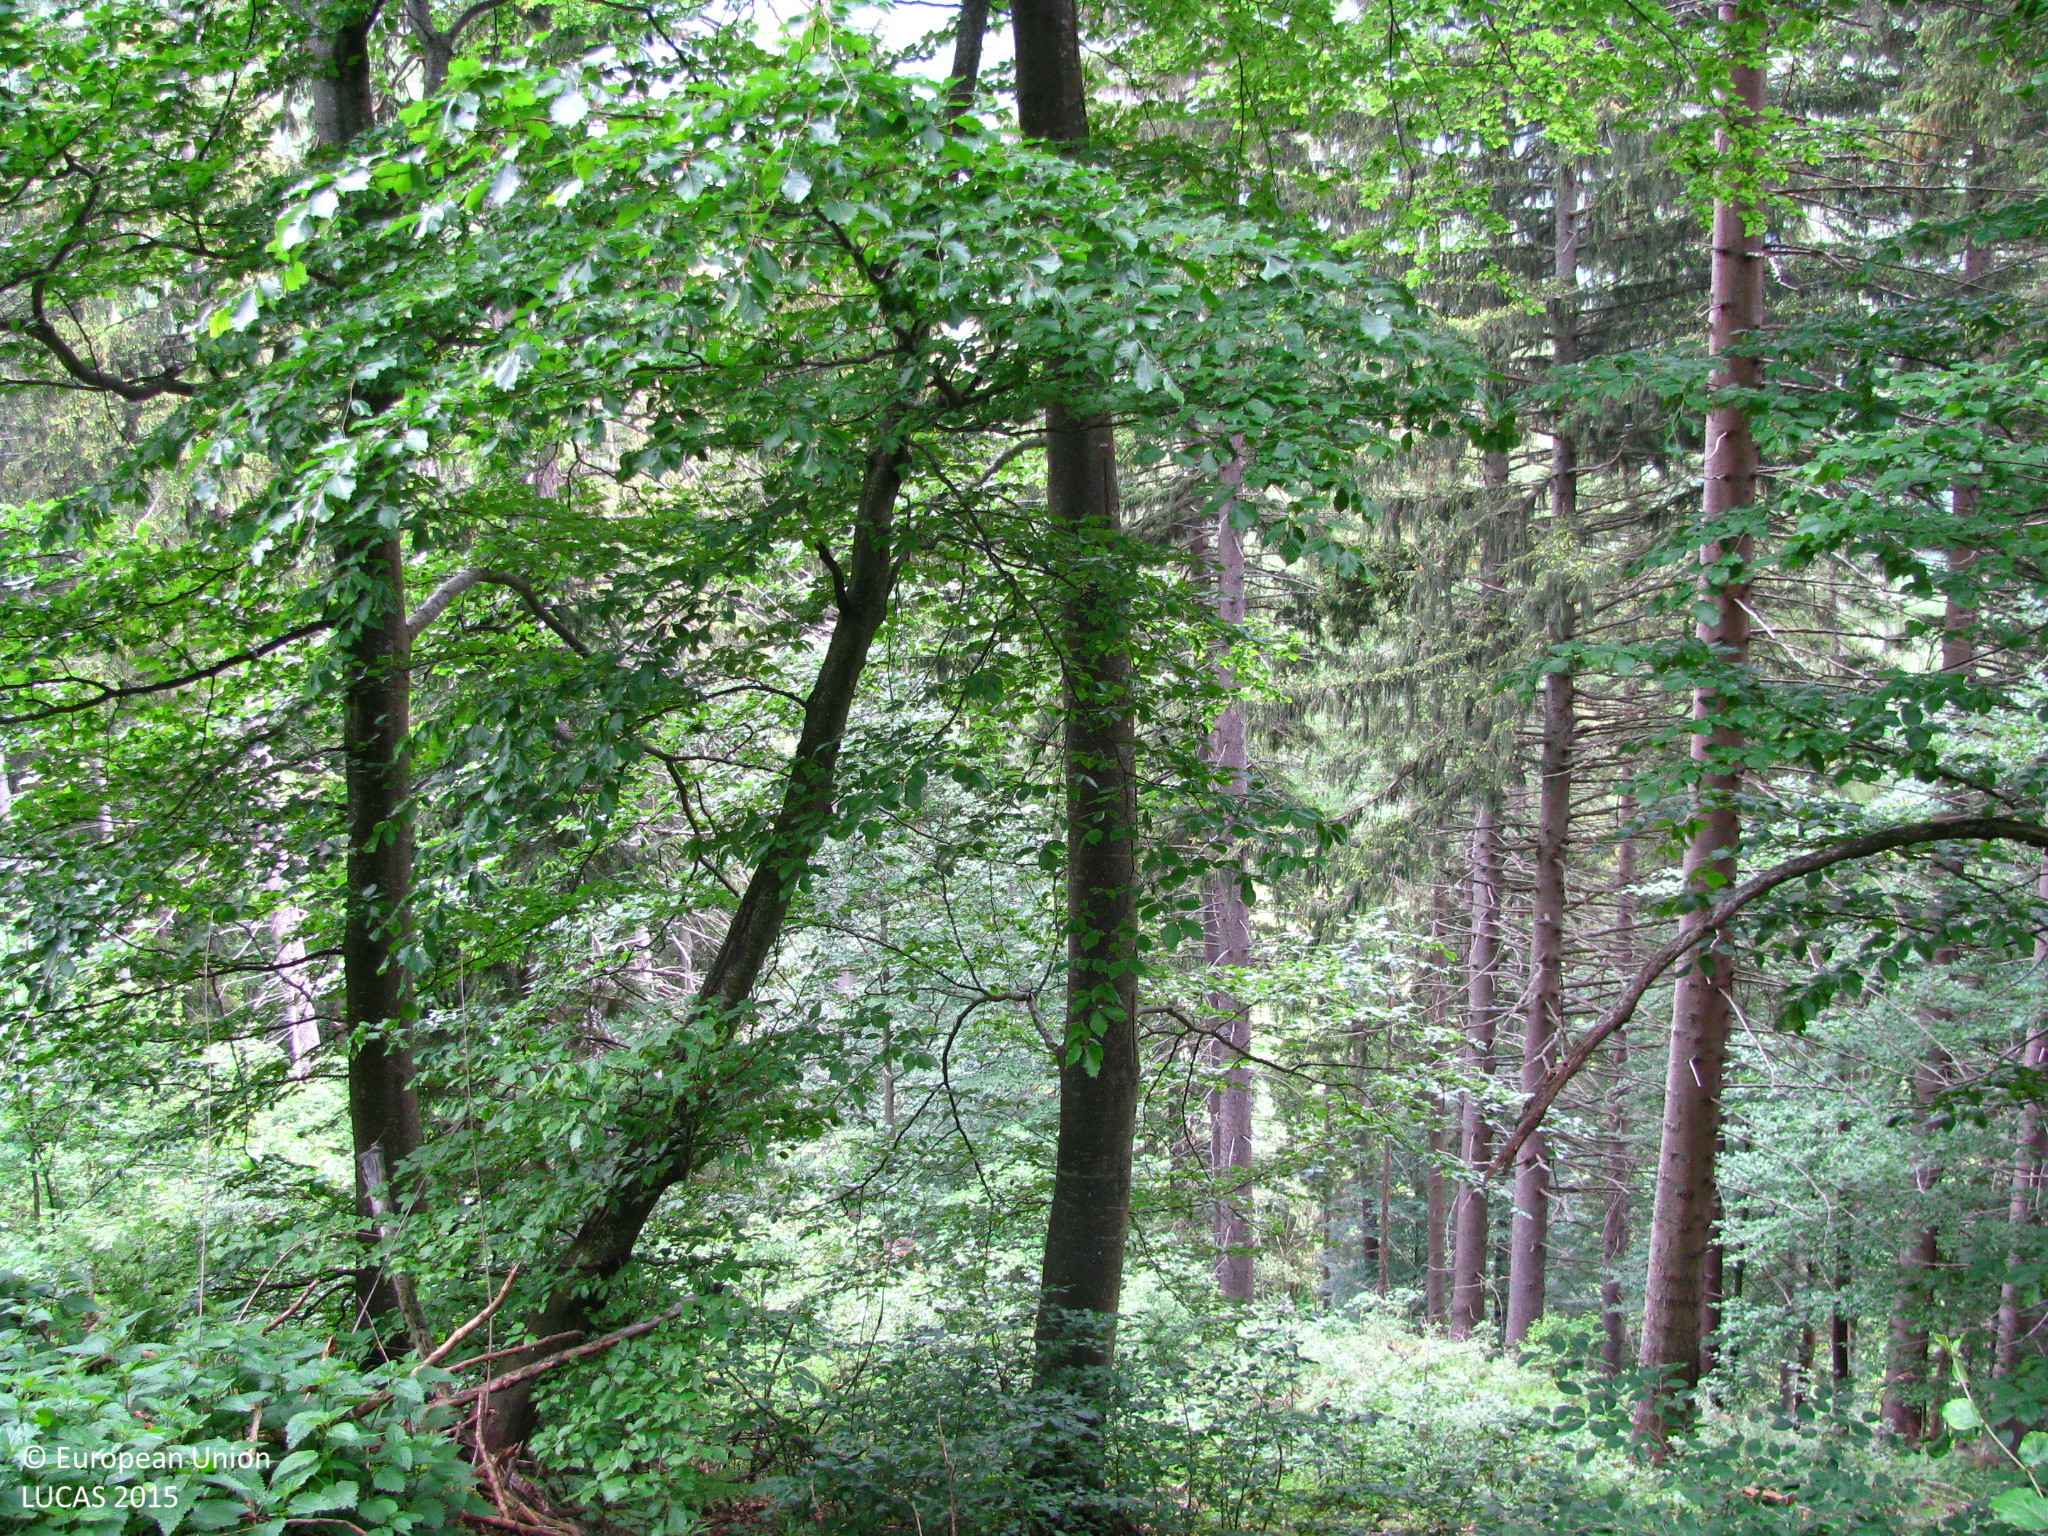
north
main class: Woodland
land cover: Spruce dominated mixed woodland
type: mountainous beech forest
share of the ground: > 75 %
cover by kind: broadleaved forest trees 45 %, coniferous forest trees 40 %, herbaceous plants 10 %, lichens and mosses 5 %
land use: Forestry
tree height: > 5 m
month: June
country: AT
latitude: 47.4622
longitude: 14.9744
